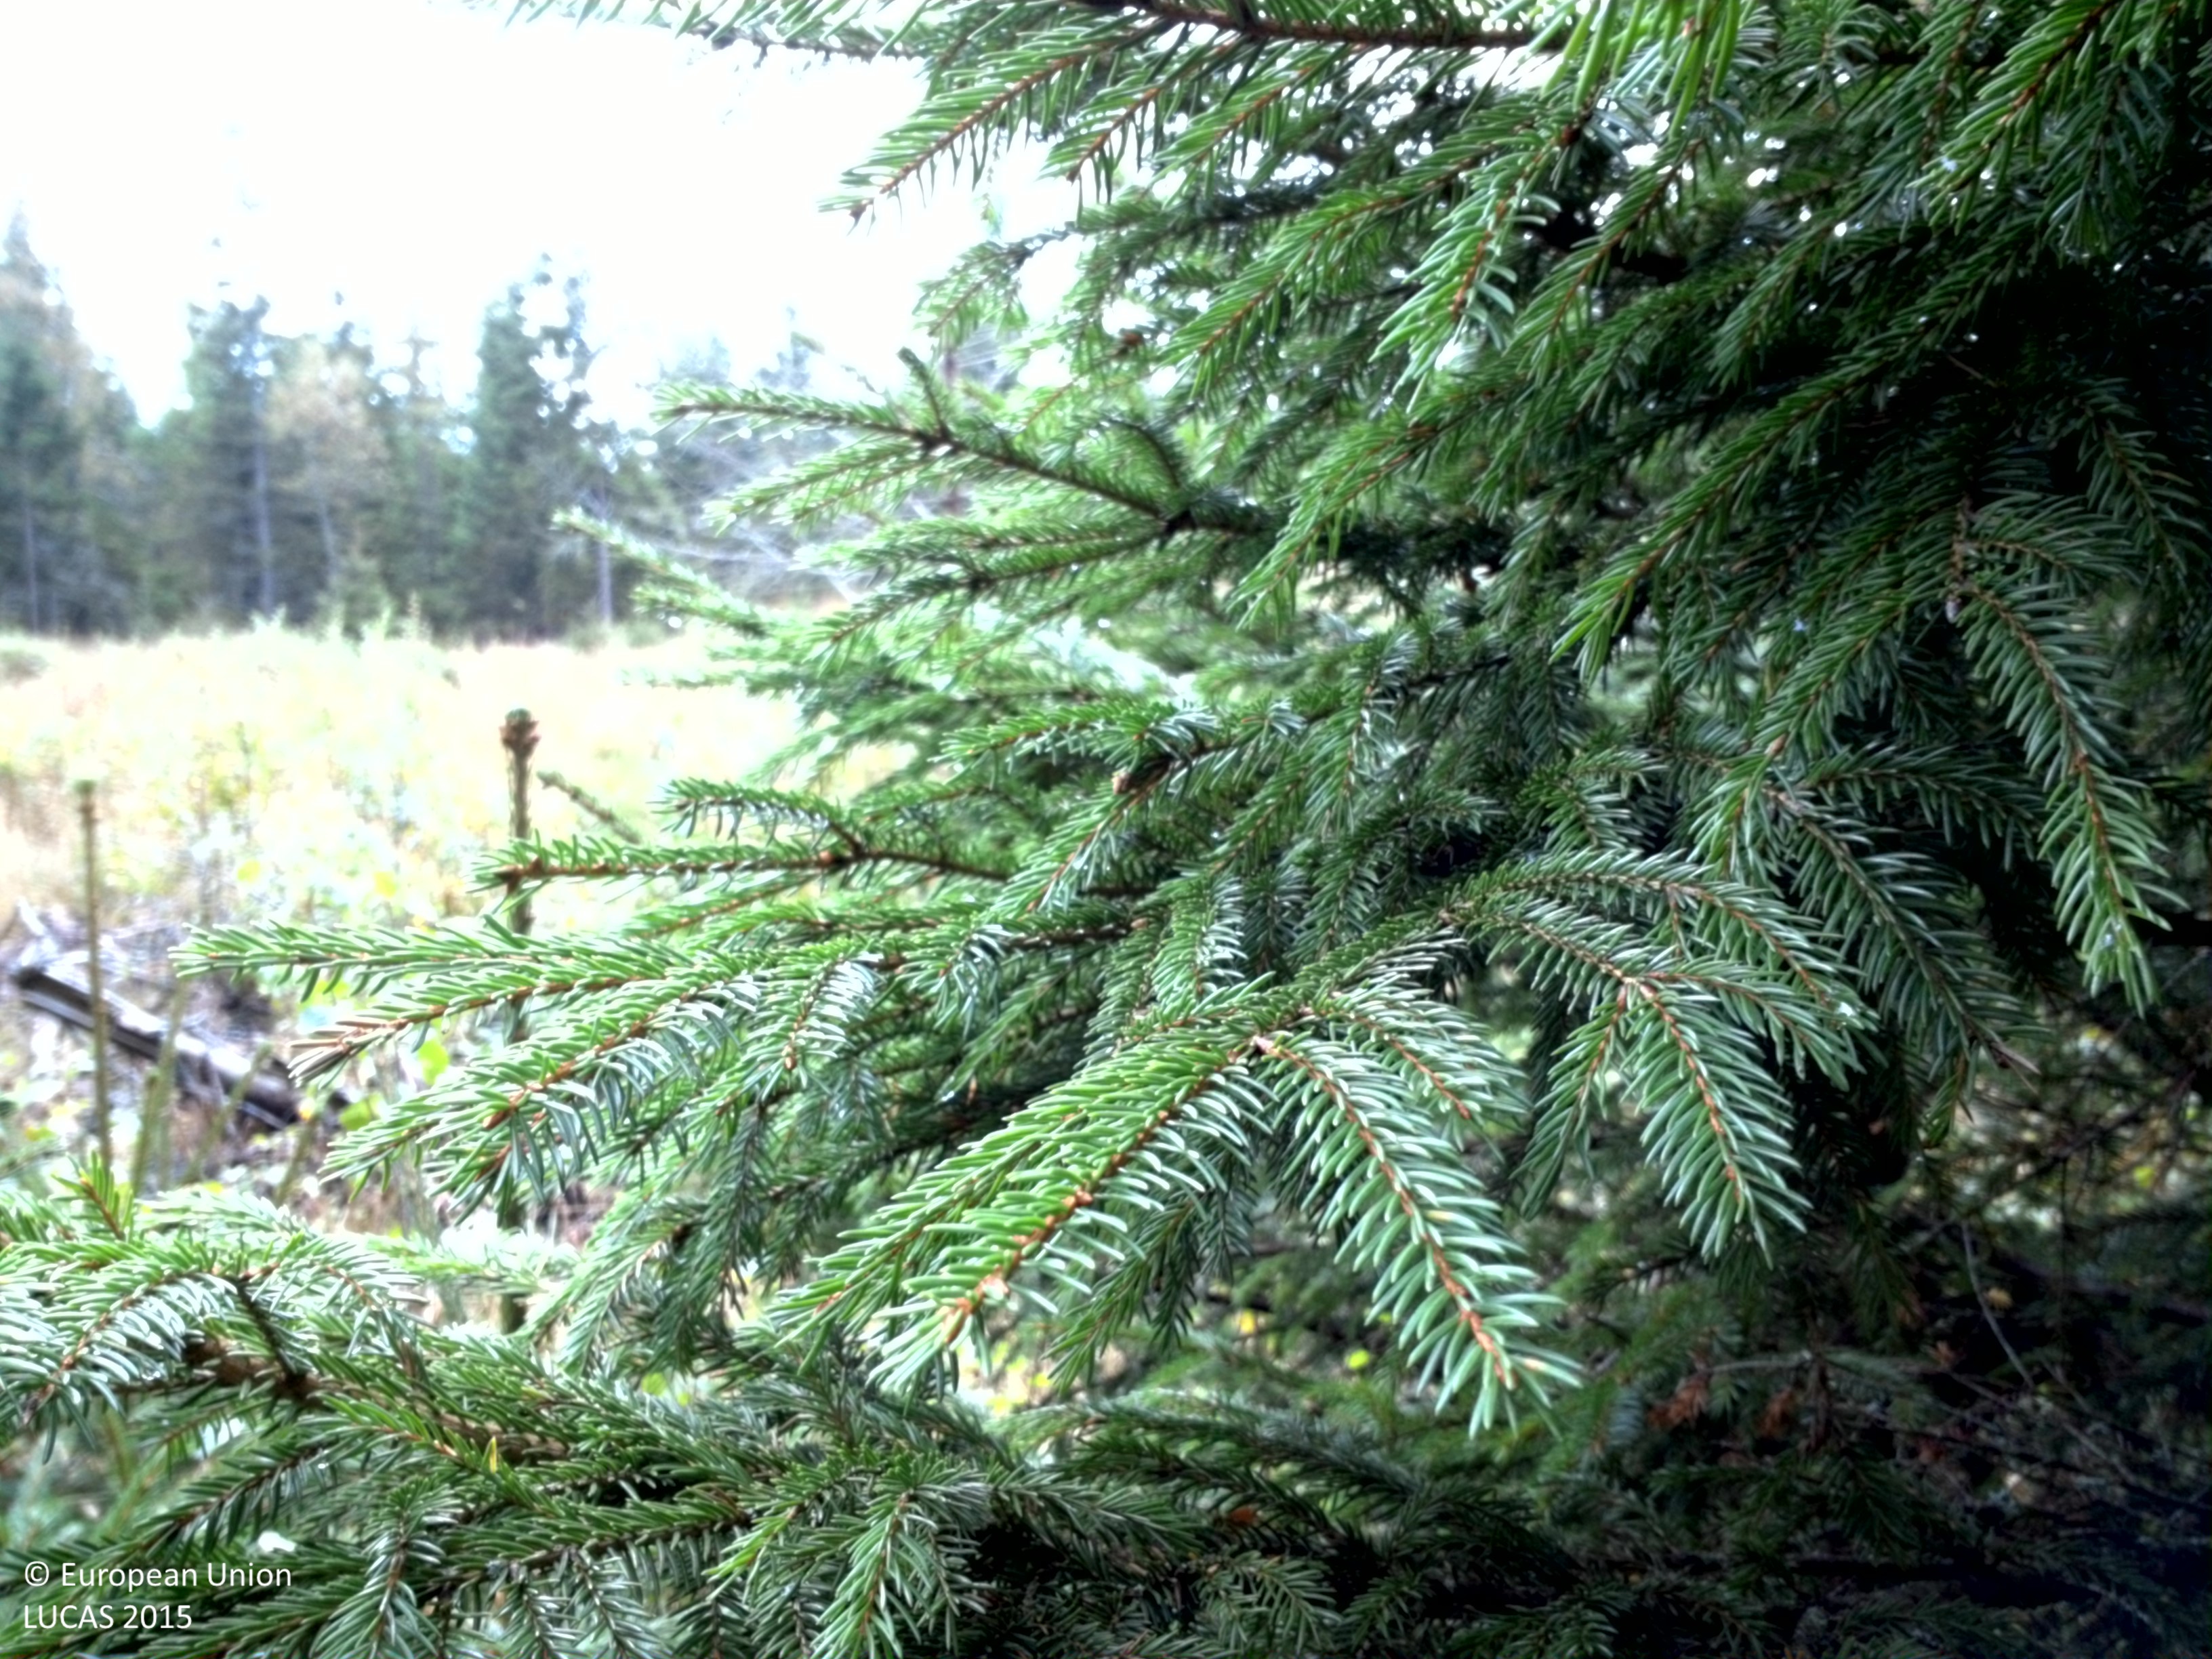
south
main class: Woodland
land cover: Spruce dominated mixed woodland
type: boreal forest
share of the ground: 25 - 50 %
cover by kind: coniferous forest trees 30 %, herbaceous plants 30 %, broadleaved forest trees 20 %, shrubs 20 %
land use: Forestry
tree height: > 5 m
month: September
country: SE
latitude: 58.1305
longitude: 13.0684
